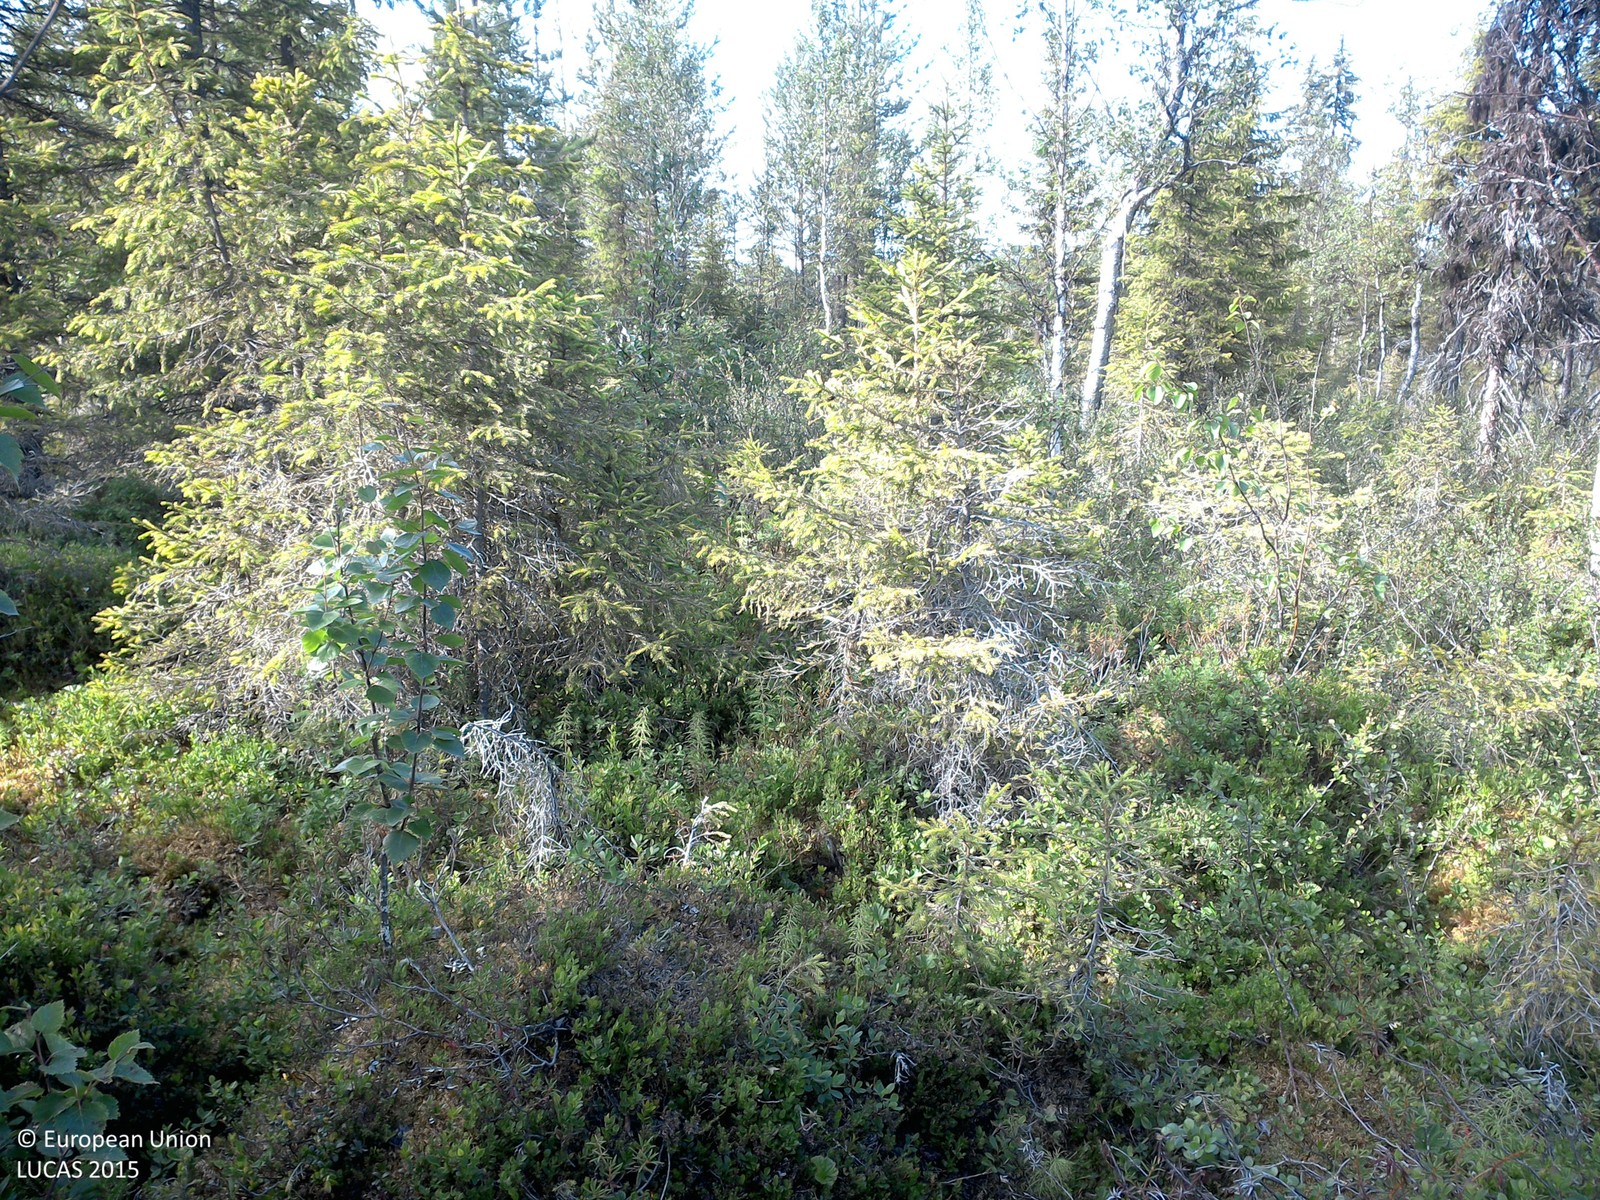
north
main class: Woodland
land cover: Spruce dominated mixed woodland
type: boreal forest
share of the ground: 25 - 50 %
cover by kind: shrubs 55 %, coniferous forest trees 20 %, broadleaved forest trees 10 %, lichens and mosses 10 %, herbaceous plants 5 %
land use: Forestry
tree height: > 5 m
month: July
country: SE
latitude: 67.1647
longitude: 22.8277
